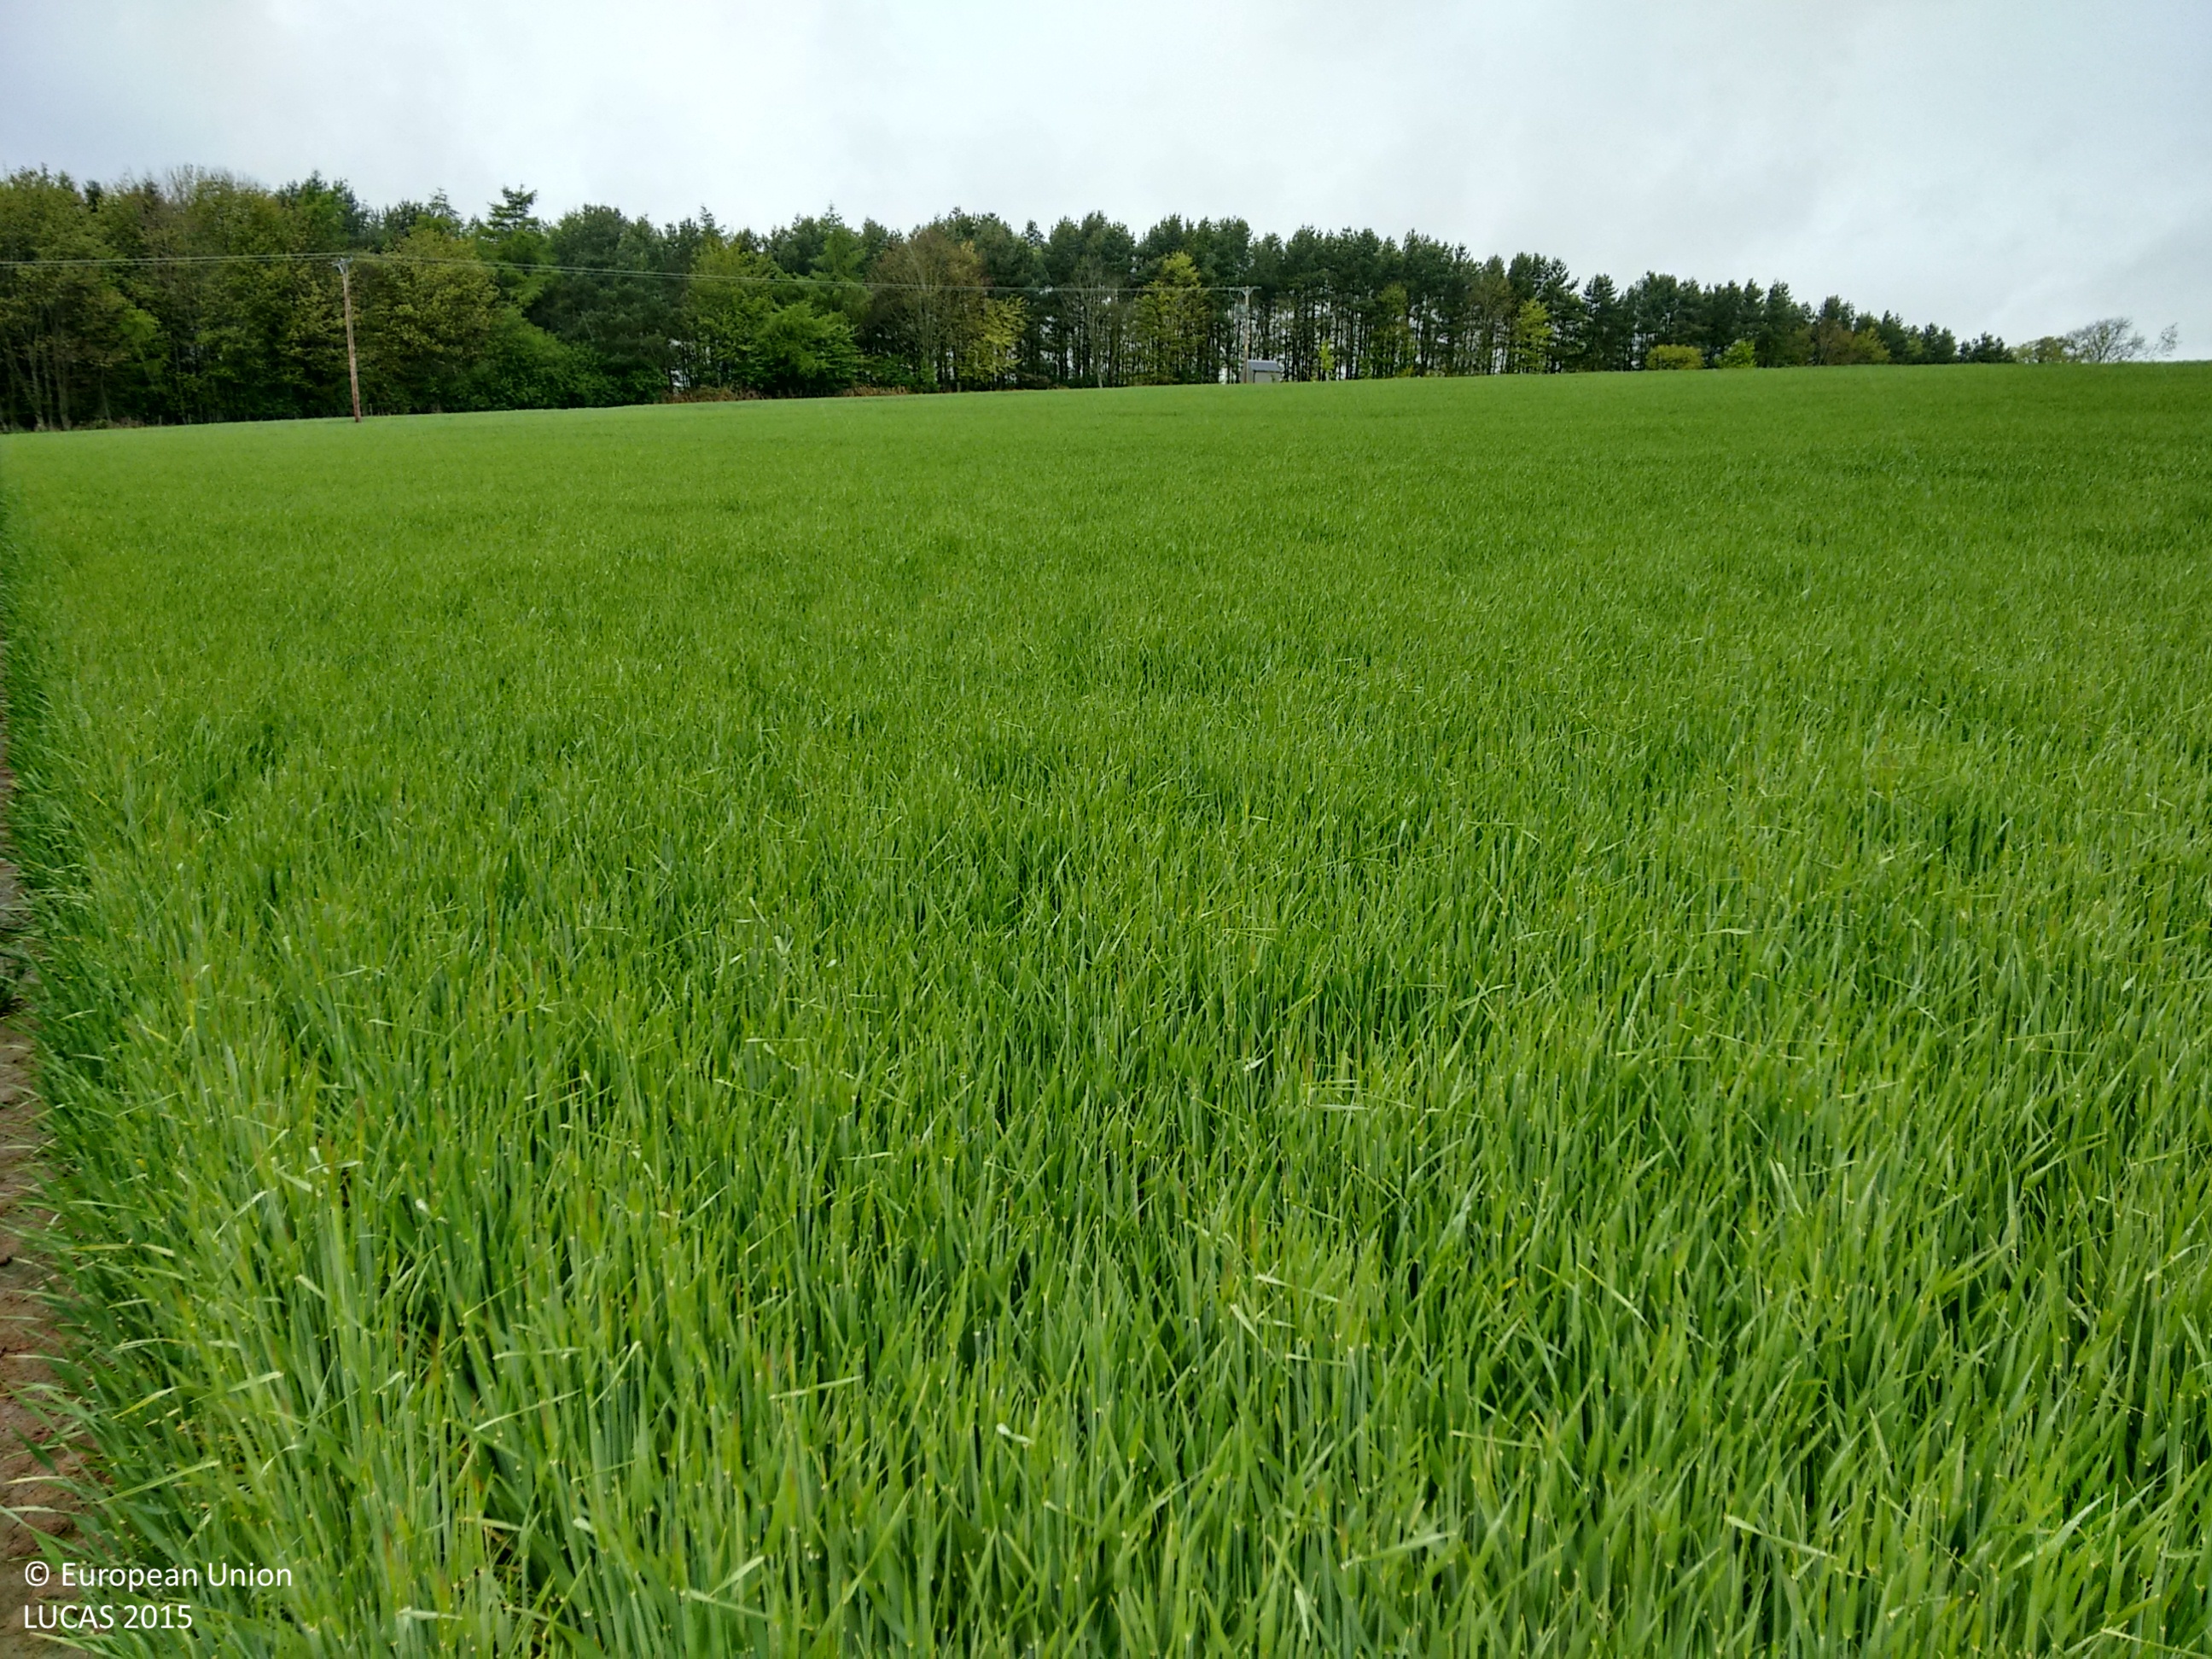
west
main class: Cropland
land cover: Barley
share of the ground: > 75 %
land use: Agriculture (excluding fallow land and kitchen gardens)
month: May
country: GB
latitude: 55.7469
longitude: -2.4048
